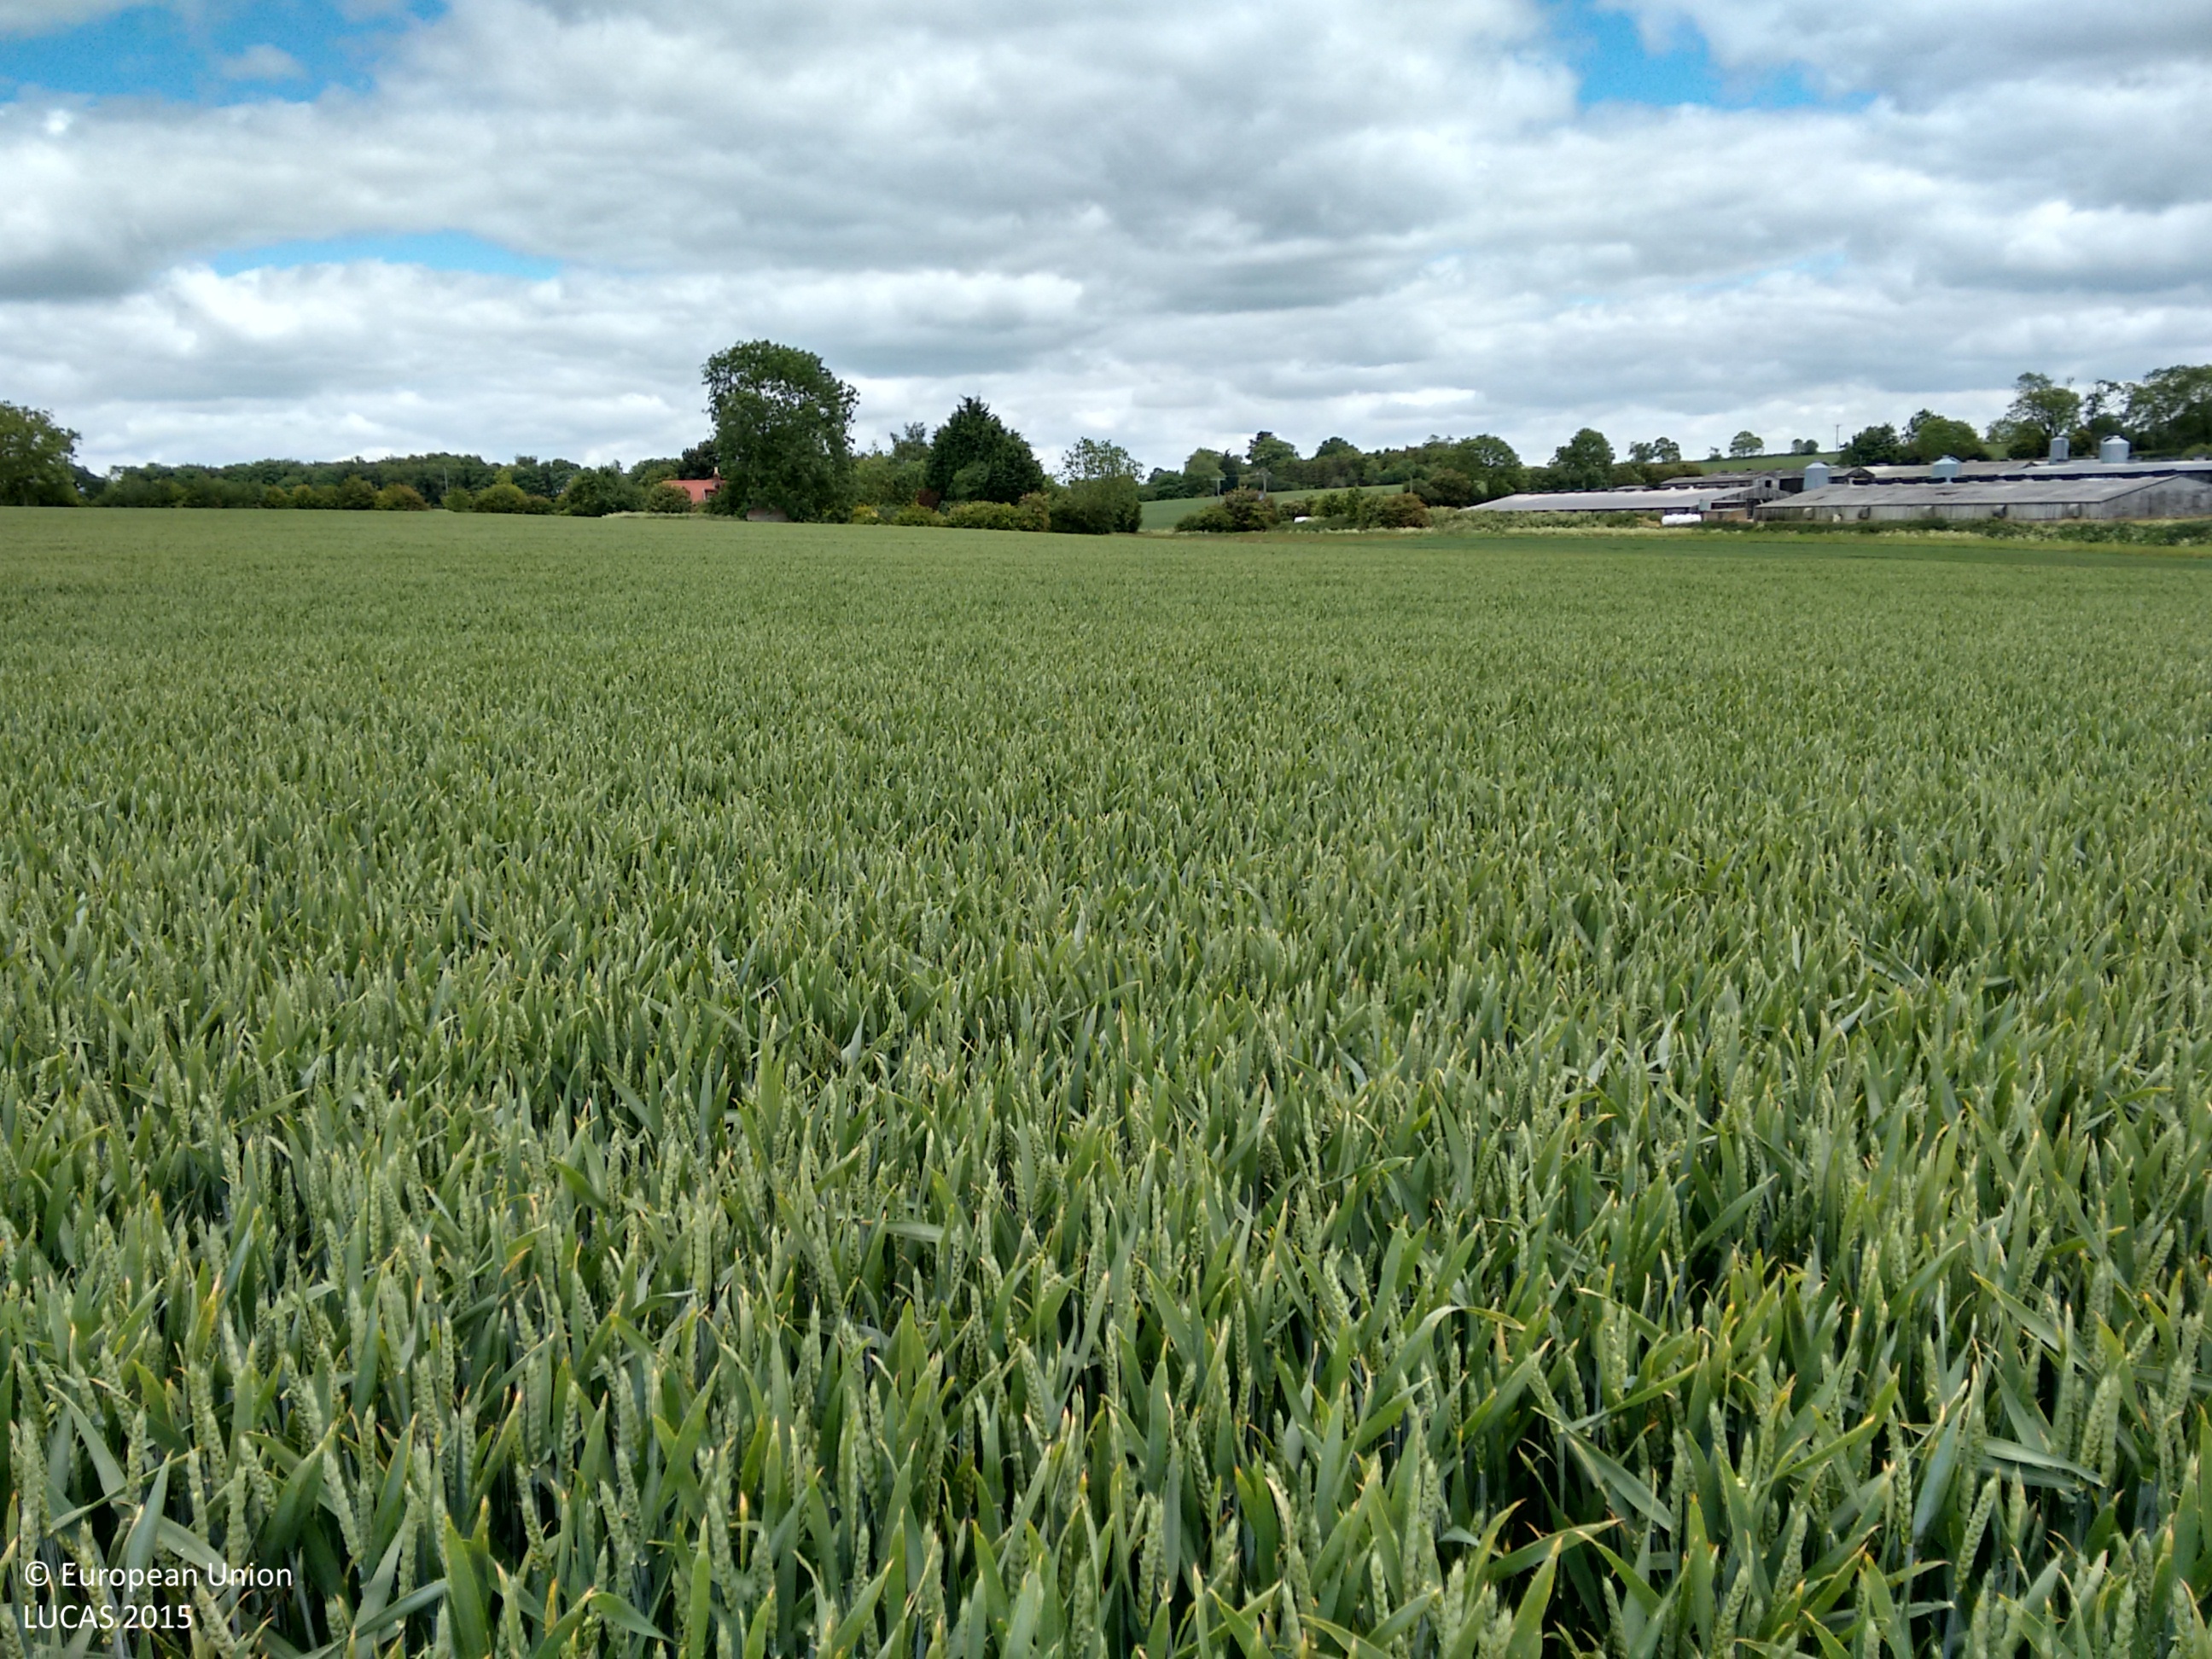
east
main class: Cropland
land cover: Common wheat
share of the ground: > 75 %
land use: Agriculture (excluding fallow land and kitchen gardens)
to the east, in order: Common wheat; Grassland without tree/shrub cover; Single bushes/trees; Grassland without tree/shrub cover; Electric lines; Grassland without tree/shrub cover; Fences; Grass margins; Paved roads, cycling and walking lanes
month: June
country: GB
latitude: 52.8732
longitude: -0.4821
